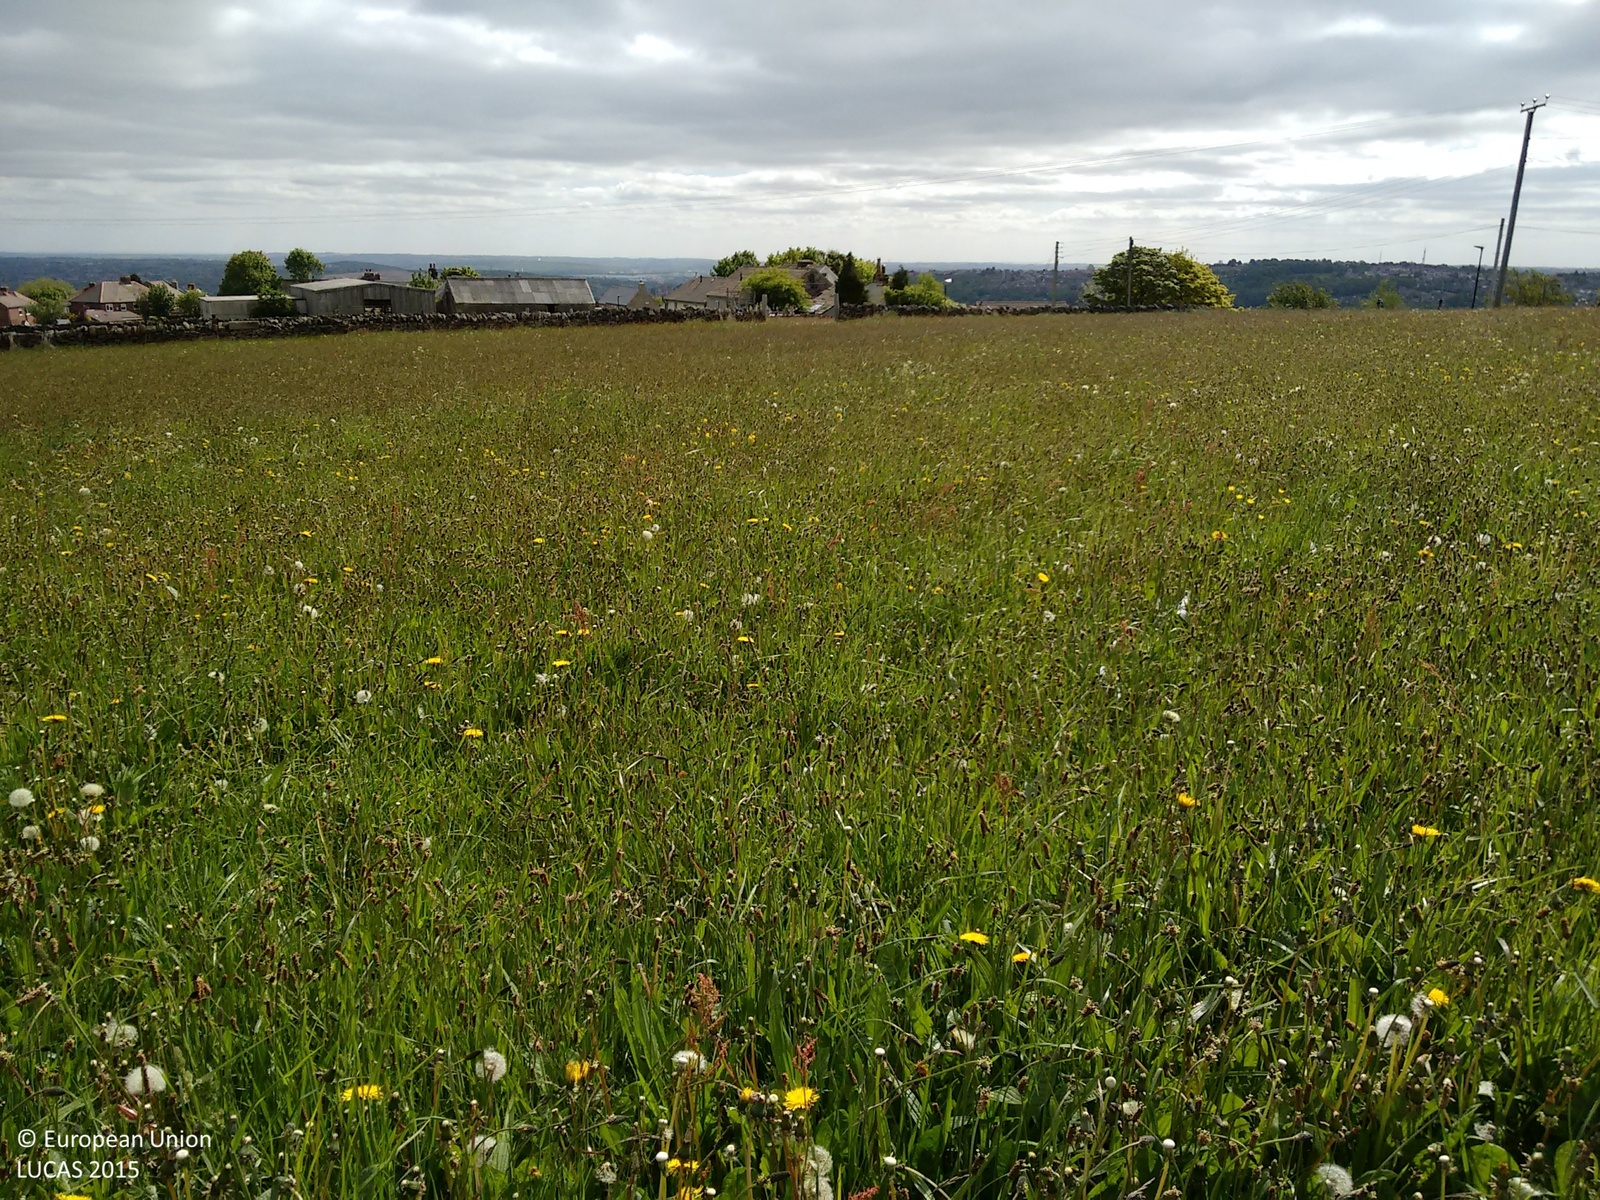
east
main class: Grassland
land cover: Grassland without tree/shrub cover
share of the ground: > 75 %
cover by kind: herbaceous plants 100 %
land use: Agriculture (excluding fallow land and kitchen gardens)
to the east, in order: Grassland without tree/shrub cover; Electric lines; Grassland without tree/shrub cover; Dry stone walls; Grassland without tree/shrub cover; Dry stone walls; Artificial constructions in urban areas
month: May
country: GB
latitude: 53.3918
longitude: -1.5544
